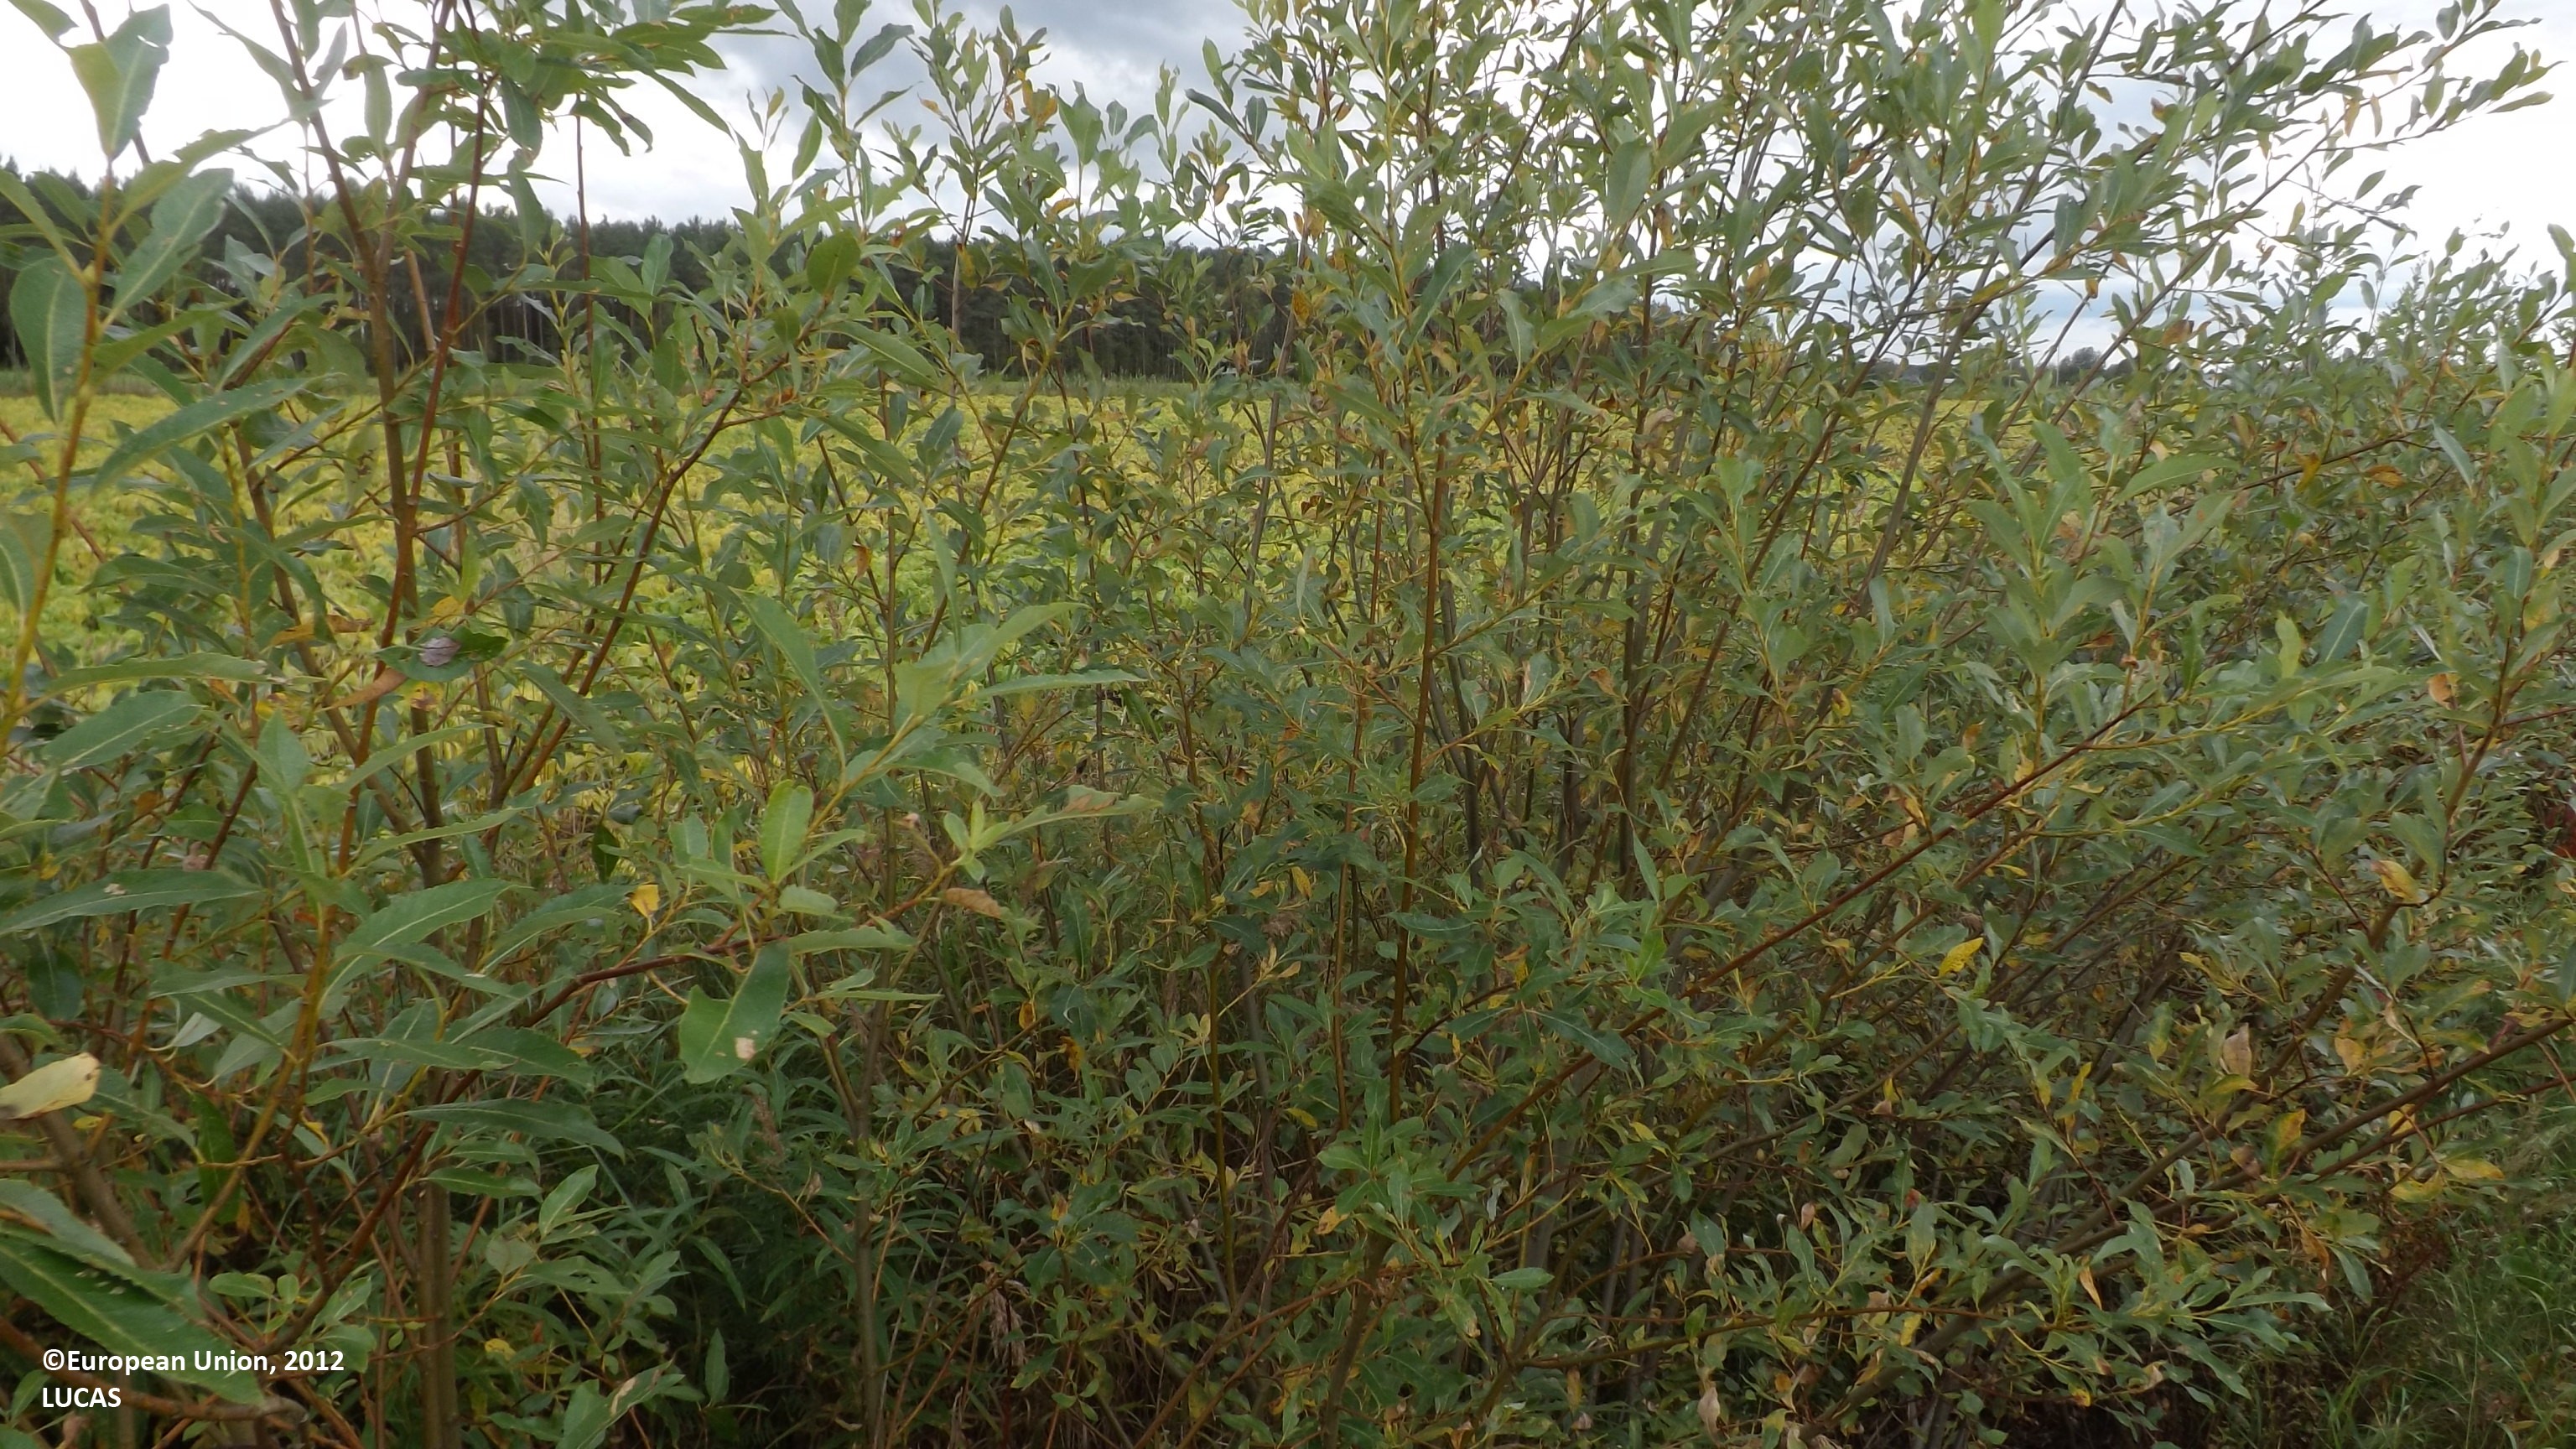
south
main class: Cropland
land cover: Barley
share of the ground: > 75 %
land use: Agriculture (excluding fallow land and kitchen gardens)
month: August
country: FI
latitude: 63.9039
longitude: 23.9829
